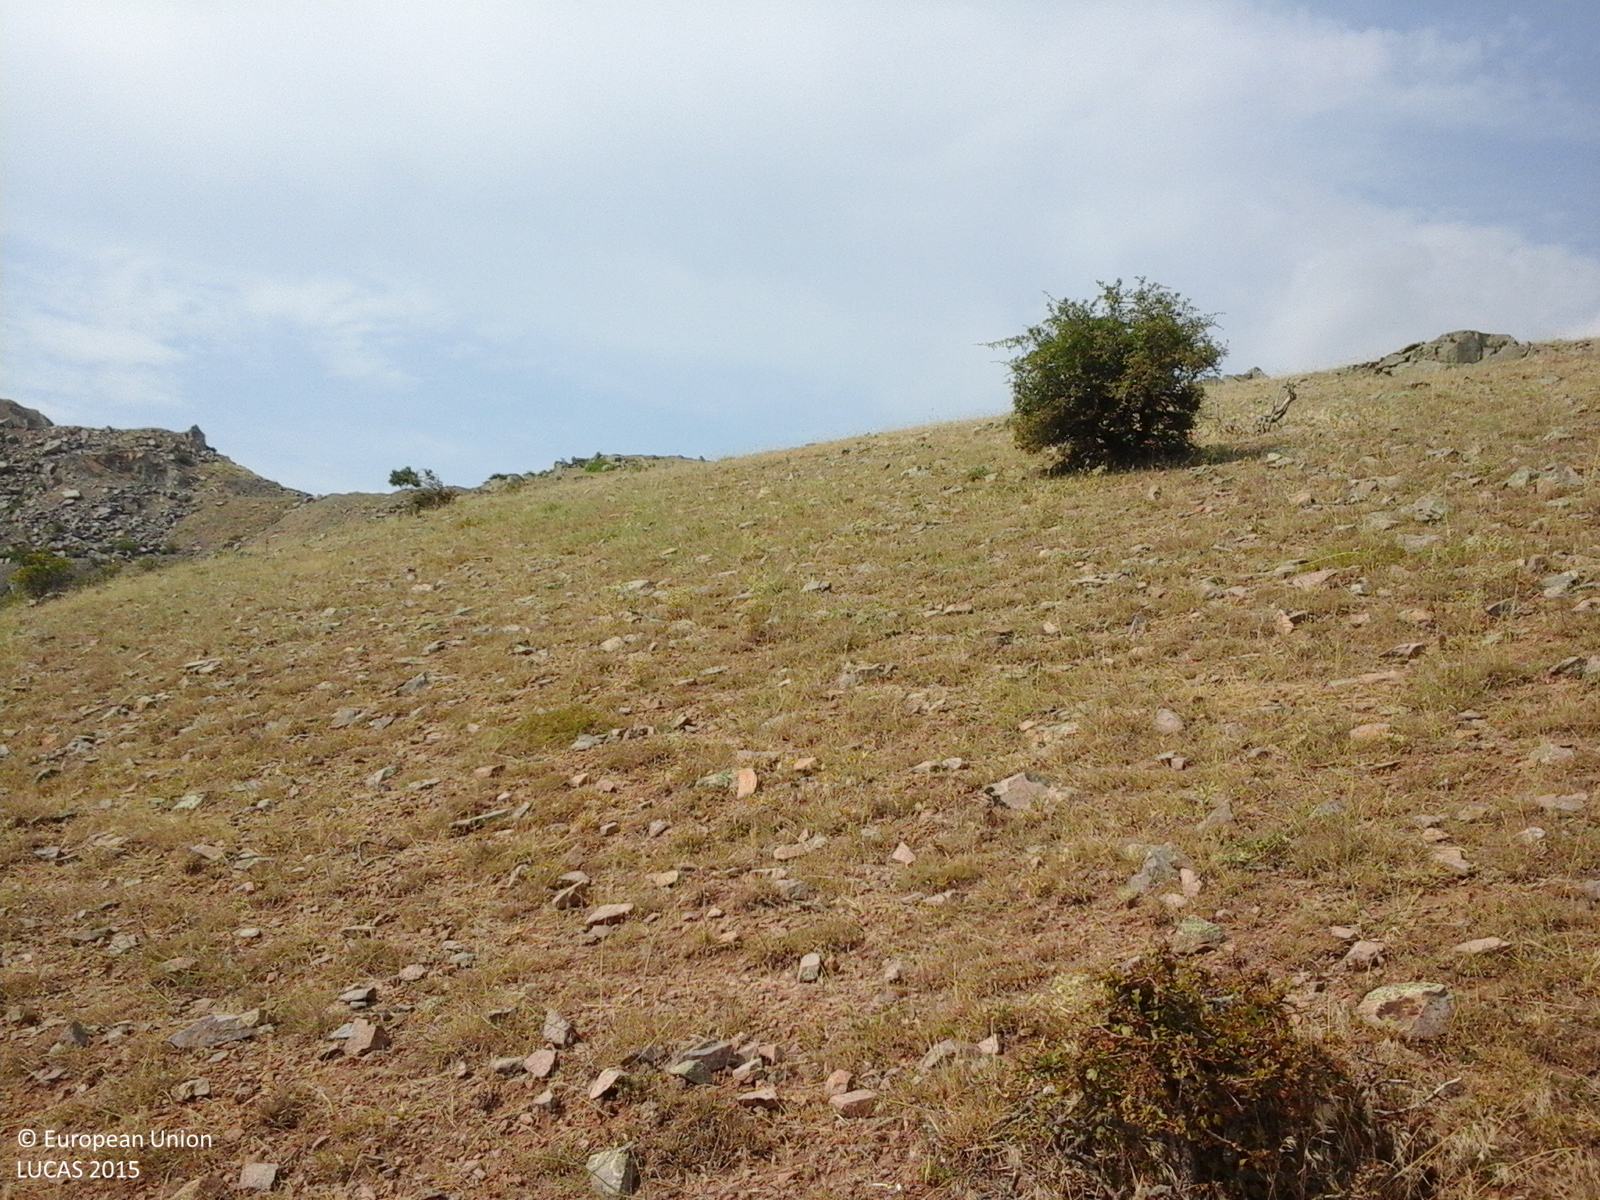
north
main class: Grassland
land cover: Grassland with sparse tree/shrub cover
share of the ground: > 75 %
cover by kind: herbaceous plants 90 %, broadleaved forest trees 5 %, shrubs 5 %
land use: Agriculture (excluding fallow land and kitchen gardens)
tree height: < 5 m
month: July
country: RO
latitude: 45.1037
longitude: 28.2050
